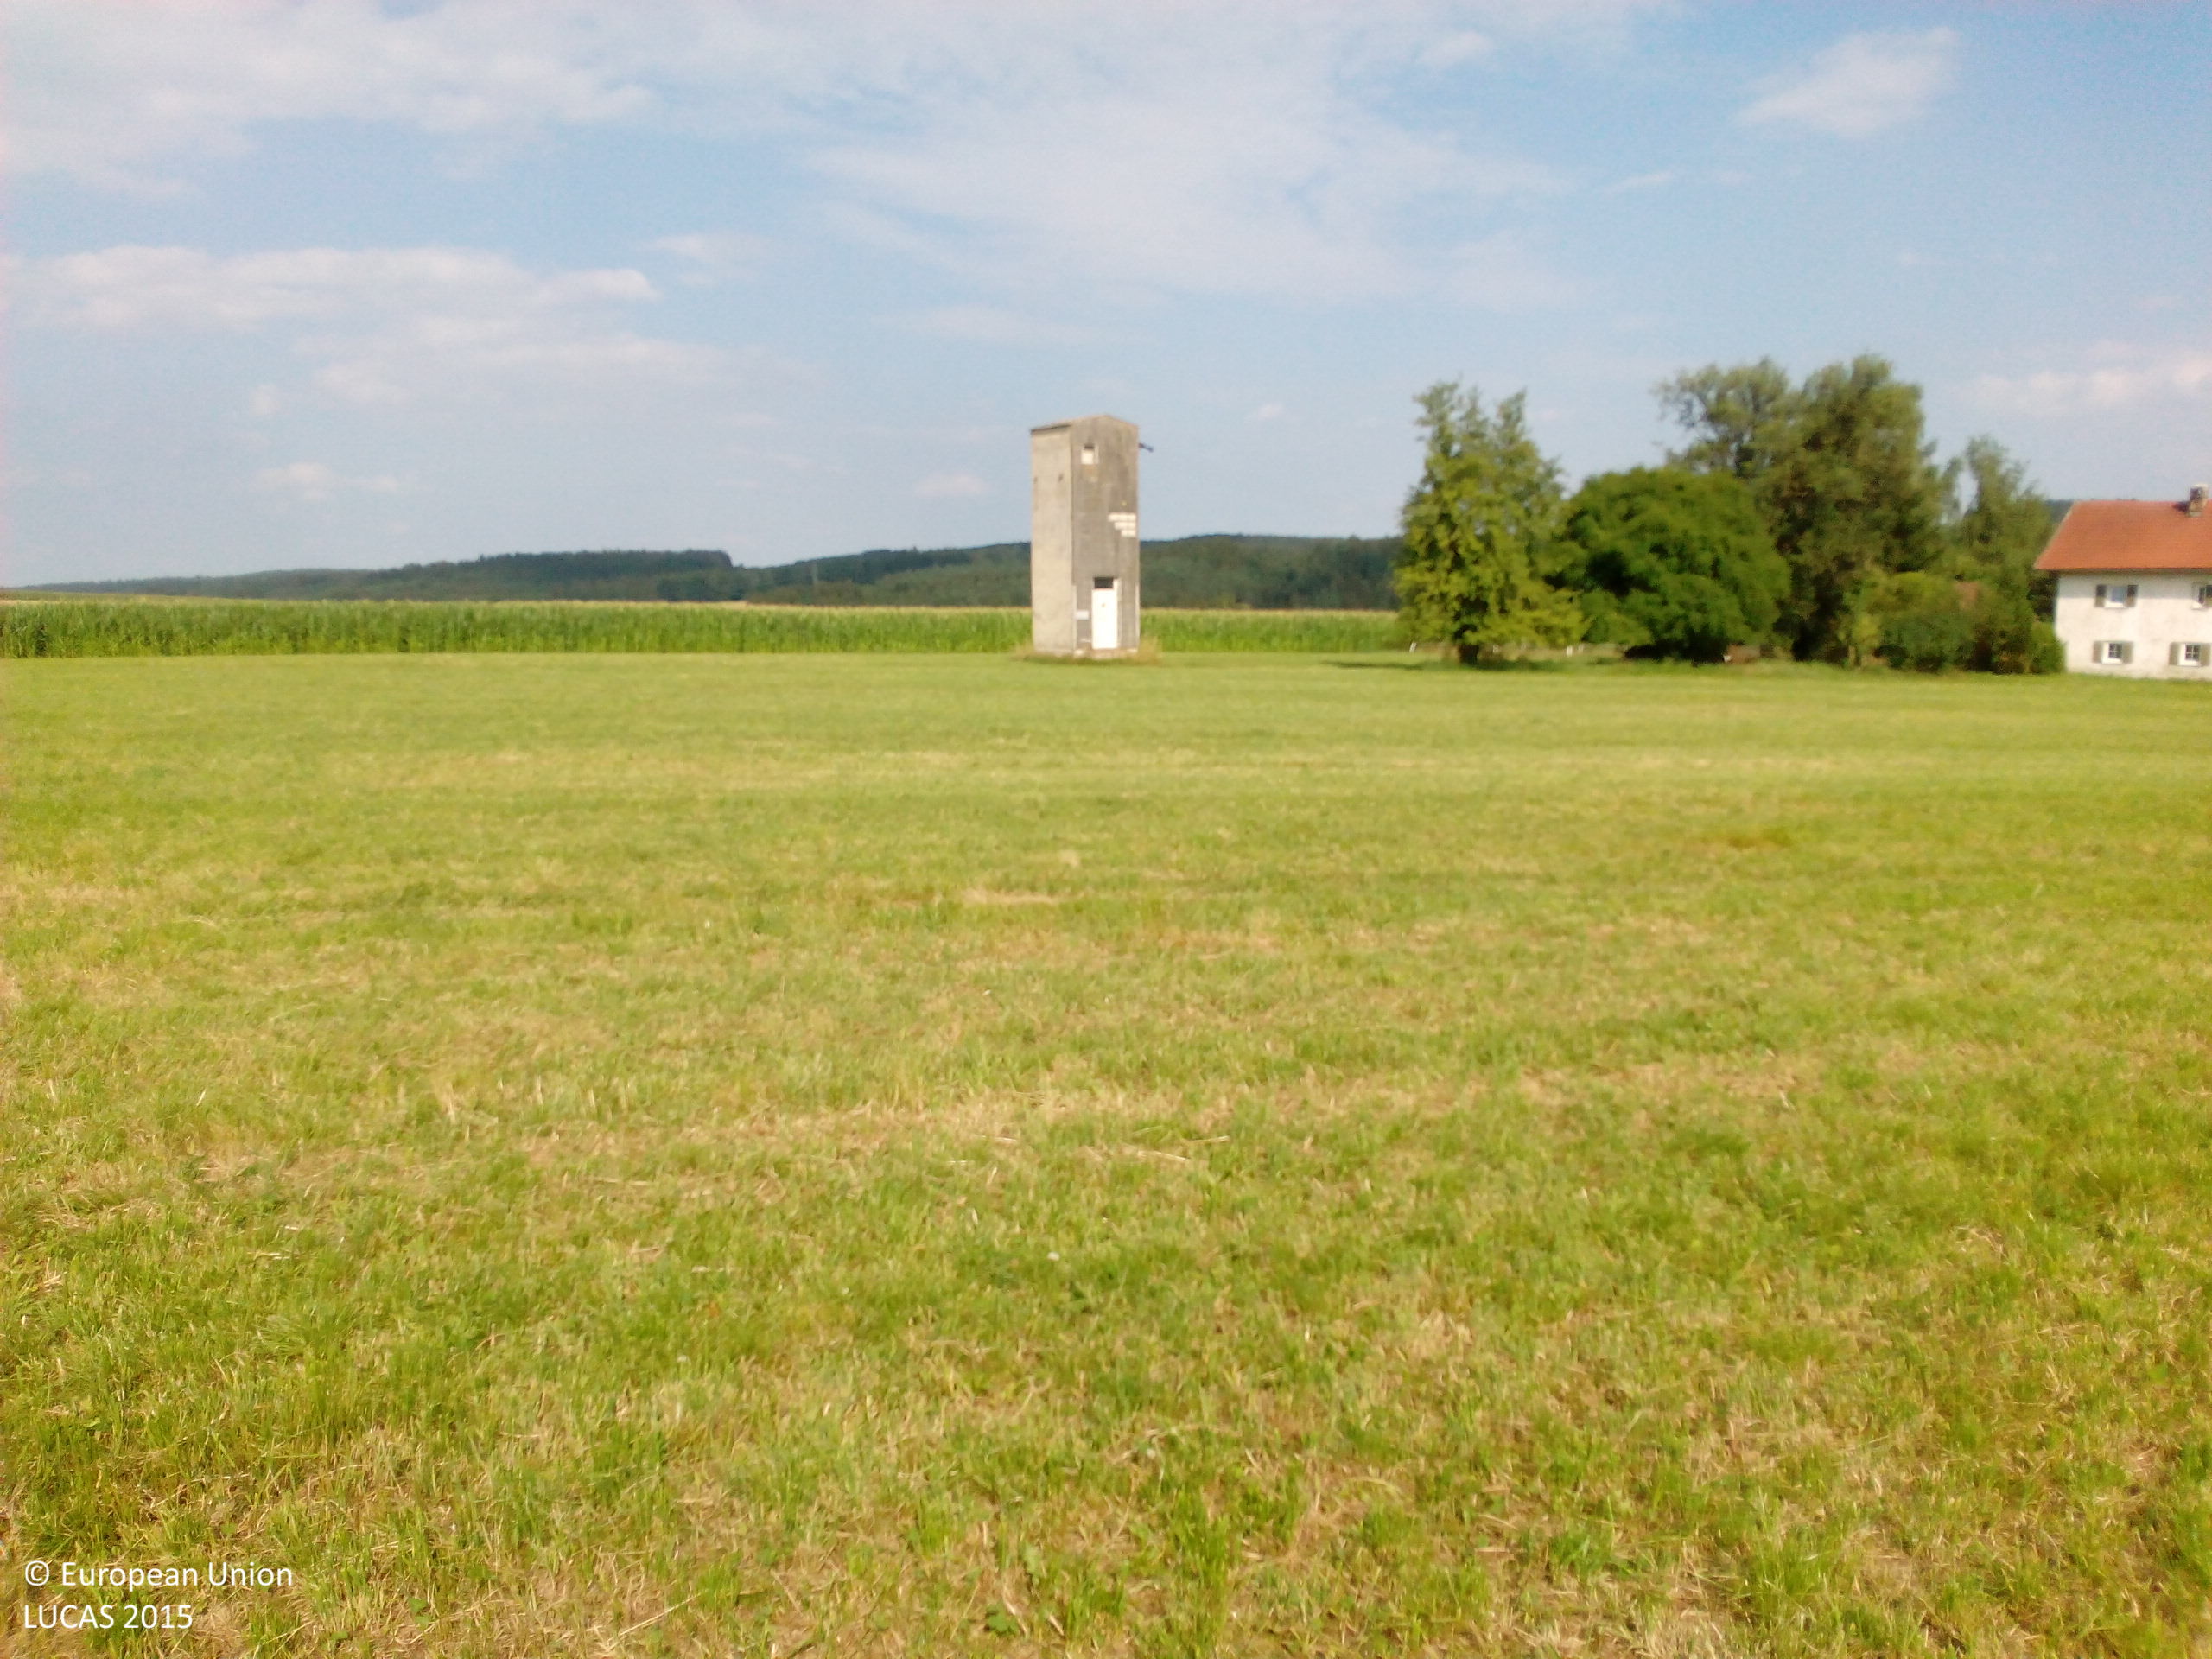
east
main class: Grassland
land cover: Grassland without tree/shrub cover
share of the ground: > 75 %
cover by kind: herbaceous plants 100 %
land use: Agriculture (excluding fallow land and kitchen gardens)
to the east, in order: Grassland without tree/shrub cover; Artificial constructions in urban areas; Grassland without tree/shrub cover; Maize; Tracks; Common wheat
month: July
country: DE
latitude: 48.3834
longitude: 12.9022
